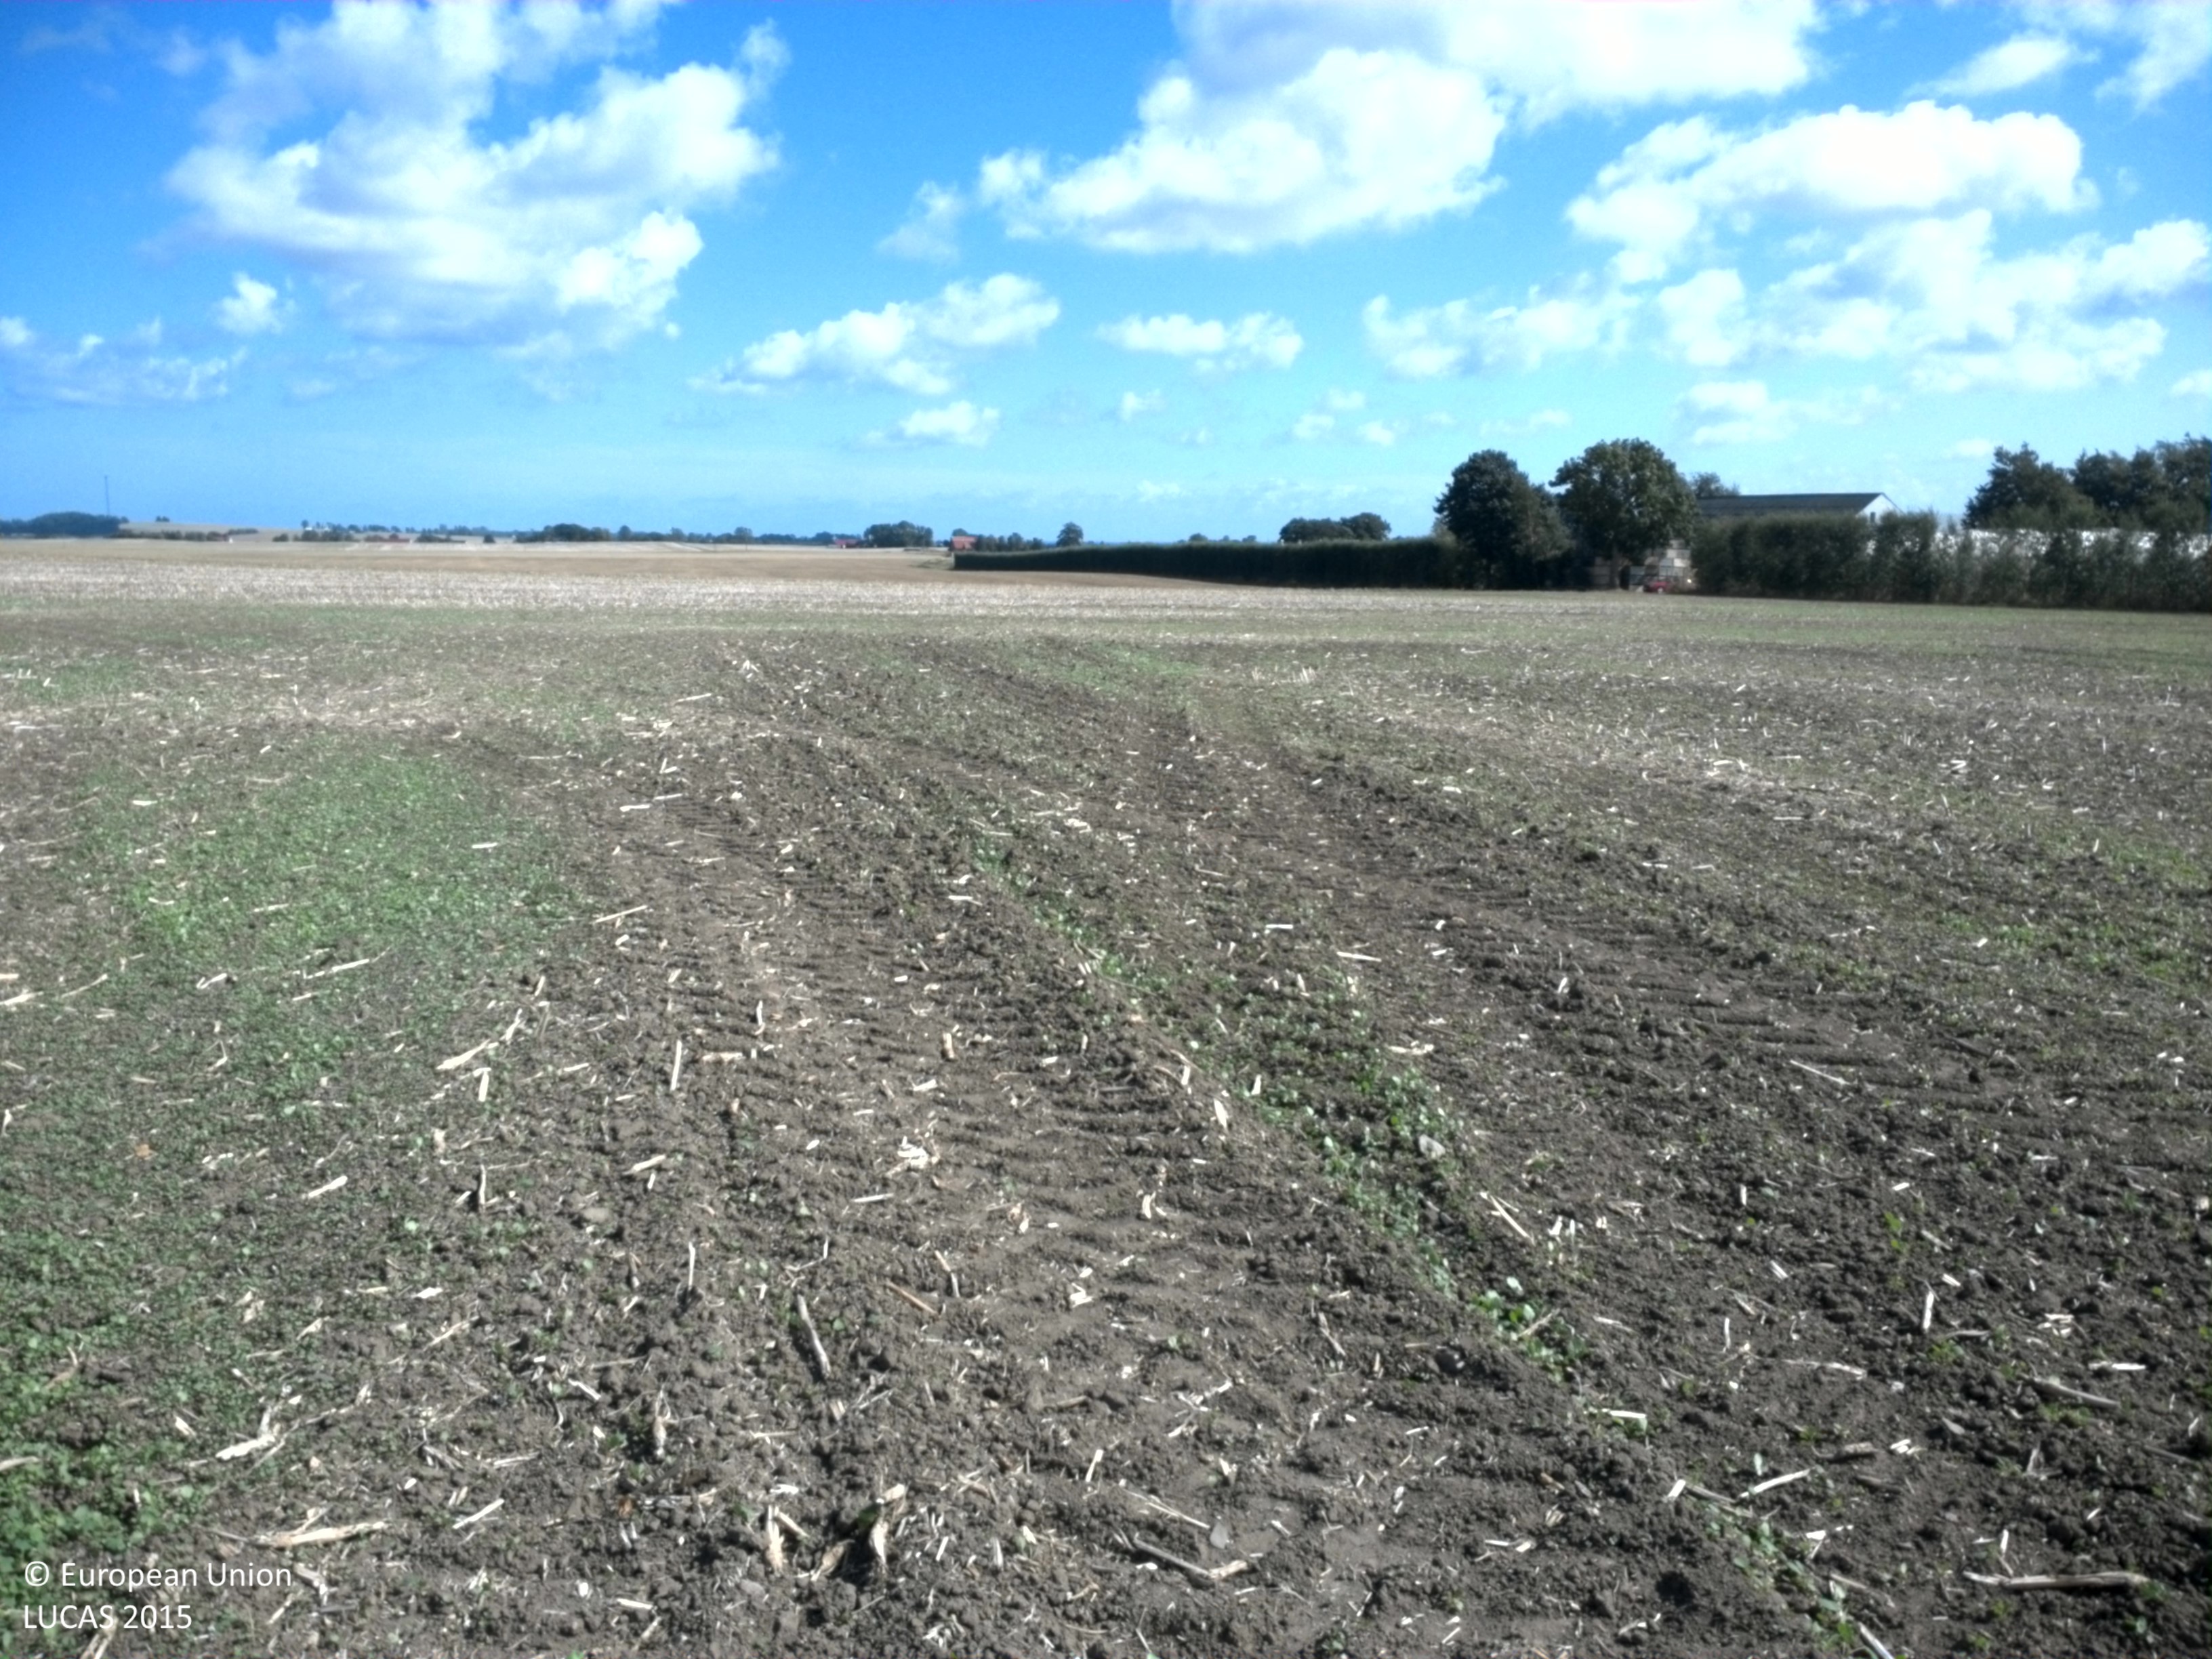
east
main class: Cropland
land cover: Rape and turnip rape
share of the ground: < 10 %
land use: Agriculture (excluding fallow land and kitchen gardens)
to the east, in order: Rape and turnip rape; Grass margins; Paved roads, cycling and walking lanes; Grass margins; Other bare soil
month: September
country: SE
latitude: 55.4893
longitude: 14.1927
